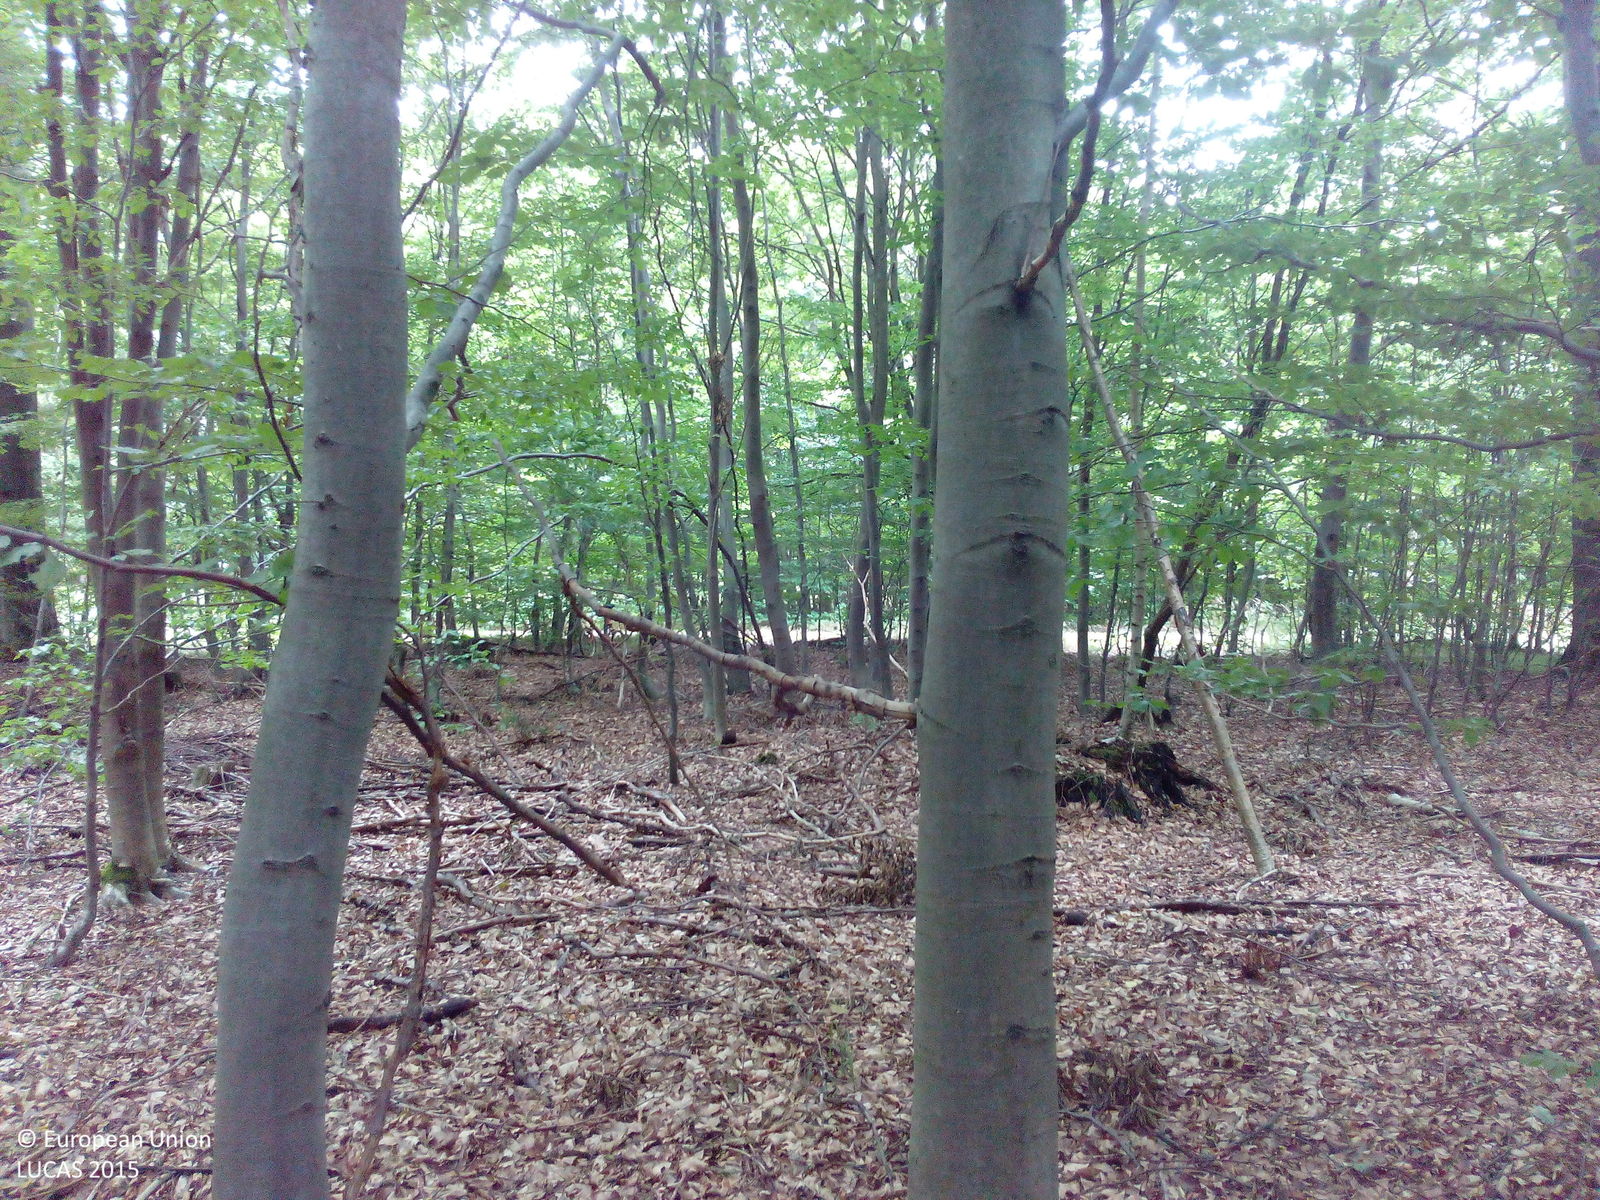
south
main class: Woodland
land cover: Broadleaved woodland
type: beech forest
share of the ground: > 75 %
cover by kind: broadleaved forest trees 100 %
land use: Forestry
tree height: > 5 m
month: August
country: DE
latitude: 51.6891
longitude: 11.1135
